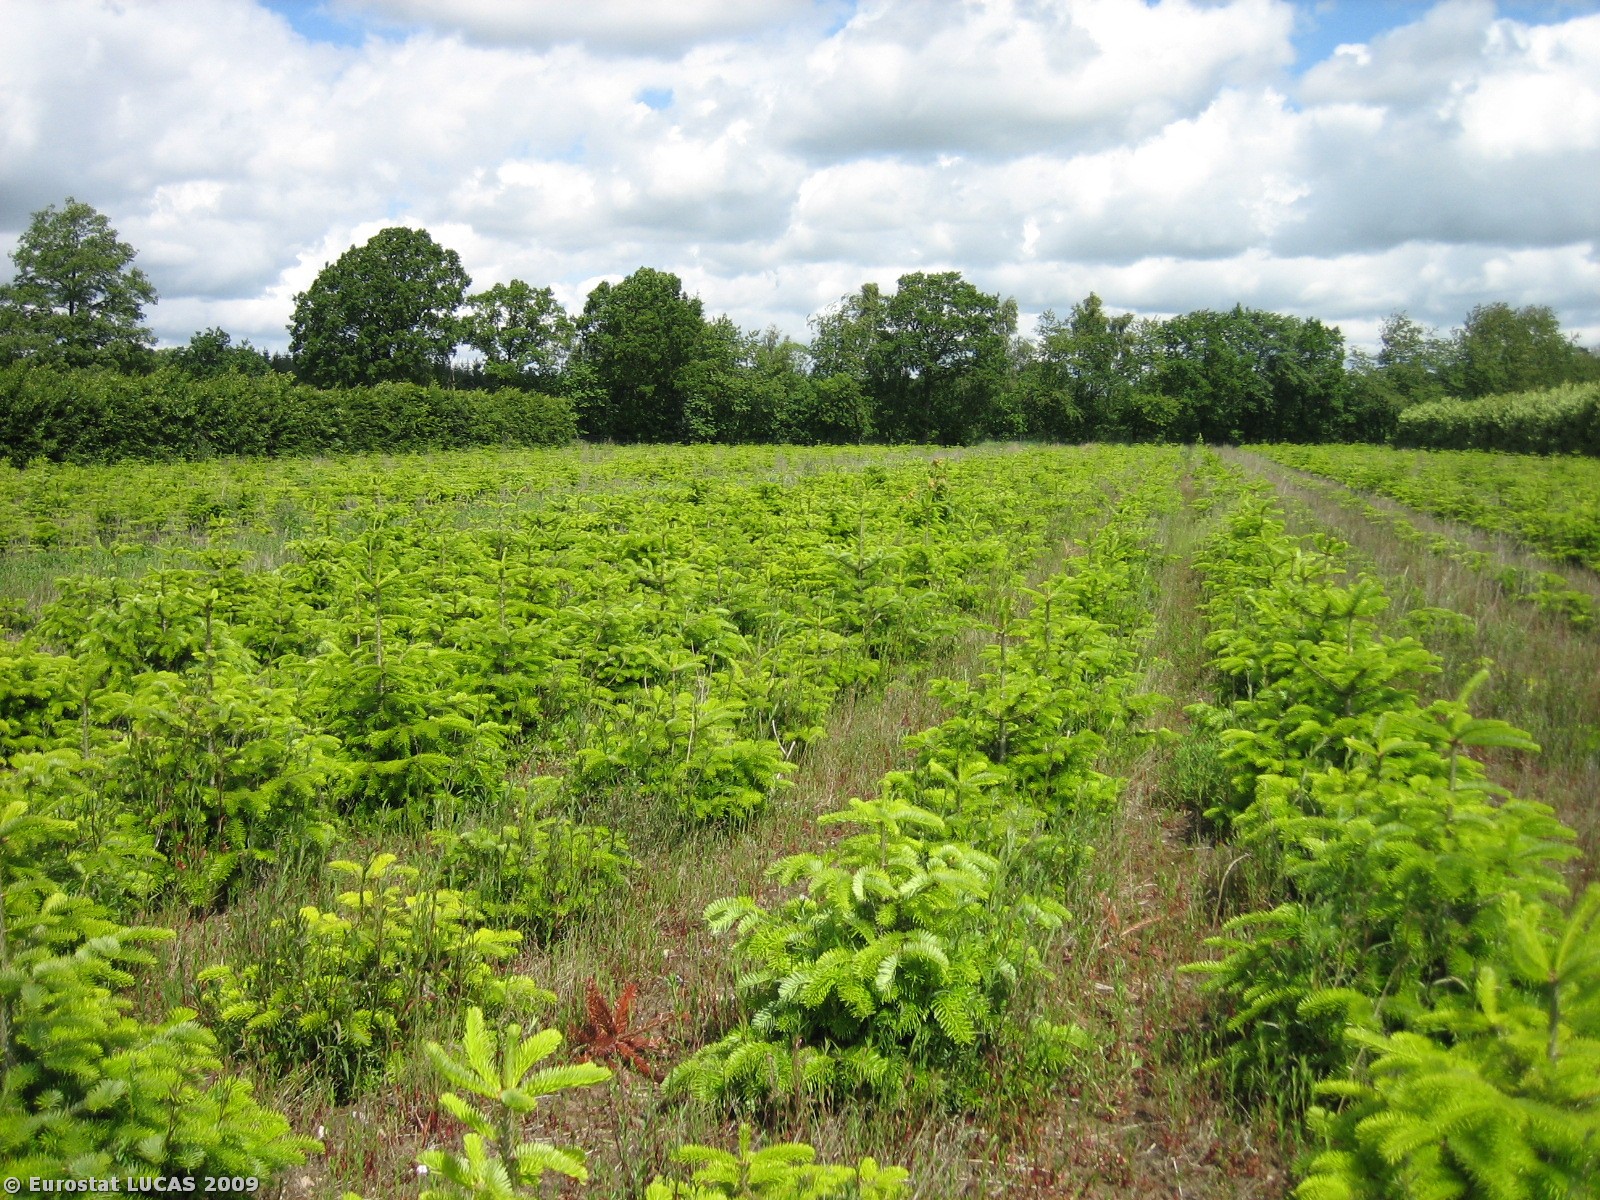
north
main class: Woodland
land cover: Coniferous woodland
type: hemiboreal forest and nemoral coniferous forest and mixed broadleaved-coniferous forest
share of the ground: 50 - 75 %
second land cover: Spontaneously vegetated surfaces
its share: 25 - 50 %
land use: Agriculture (excluding fallow land and kitchen gardens)
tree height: > 5 m
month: June
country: DK
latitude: 55.7184
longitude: 9.2844
